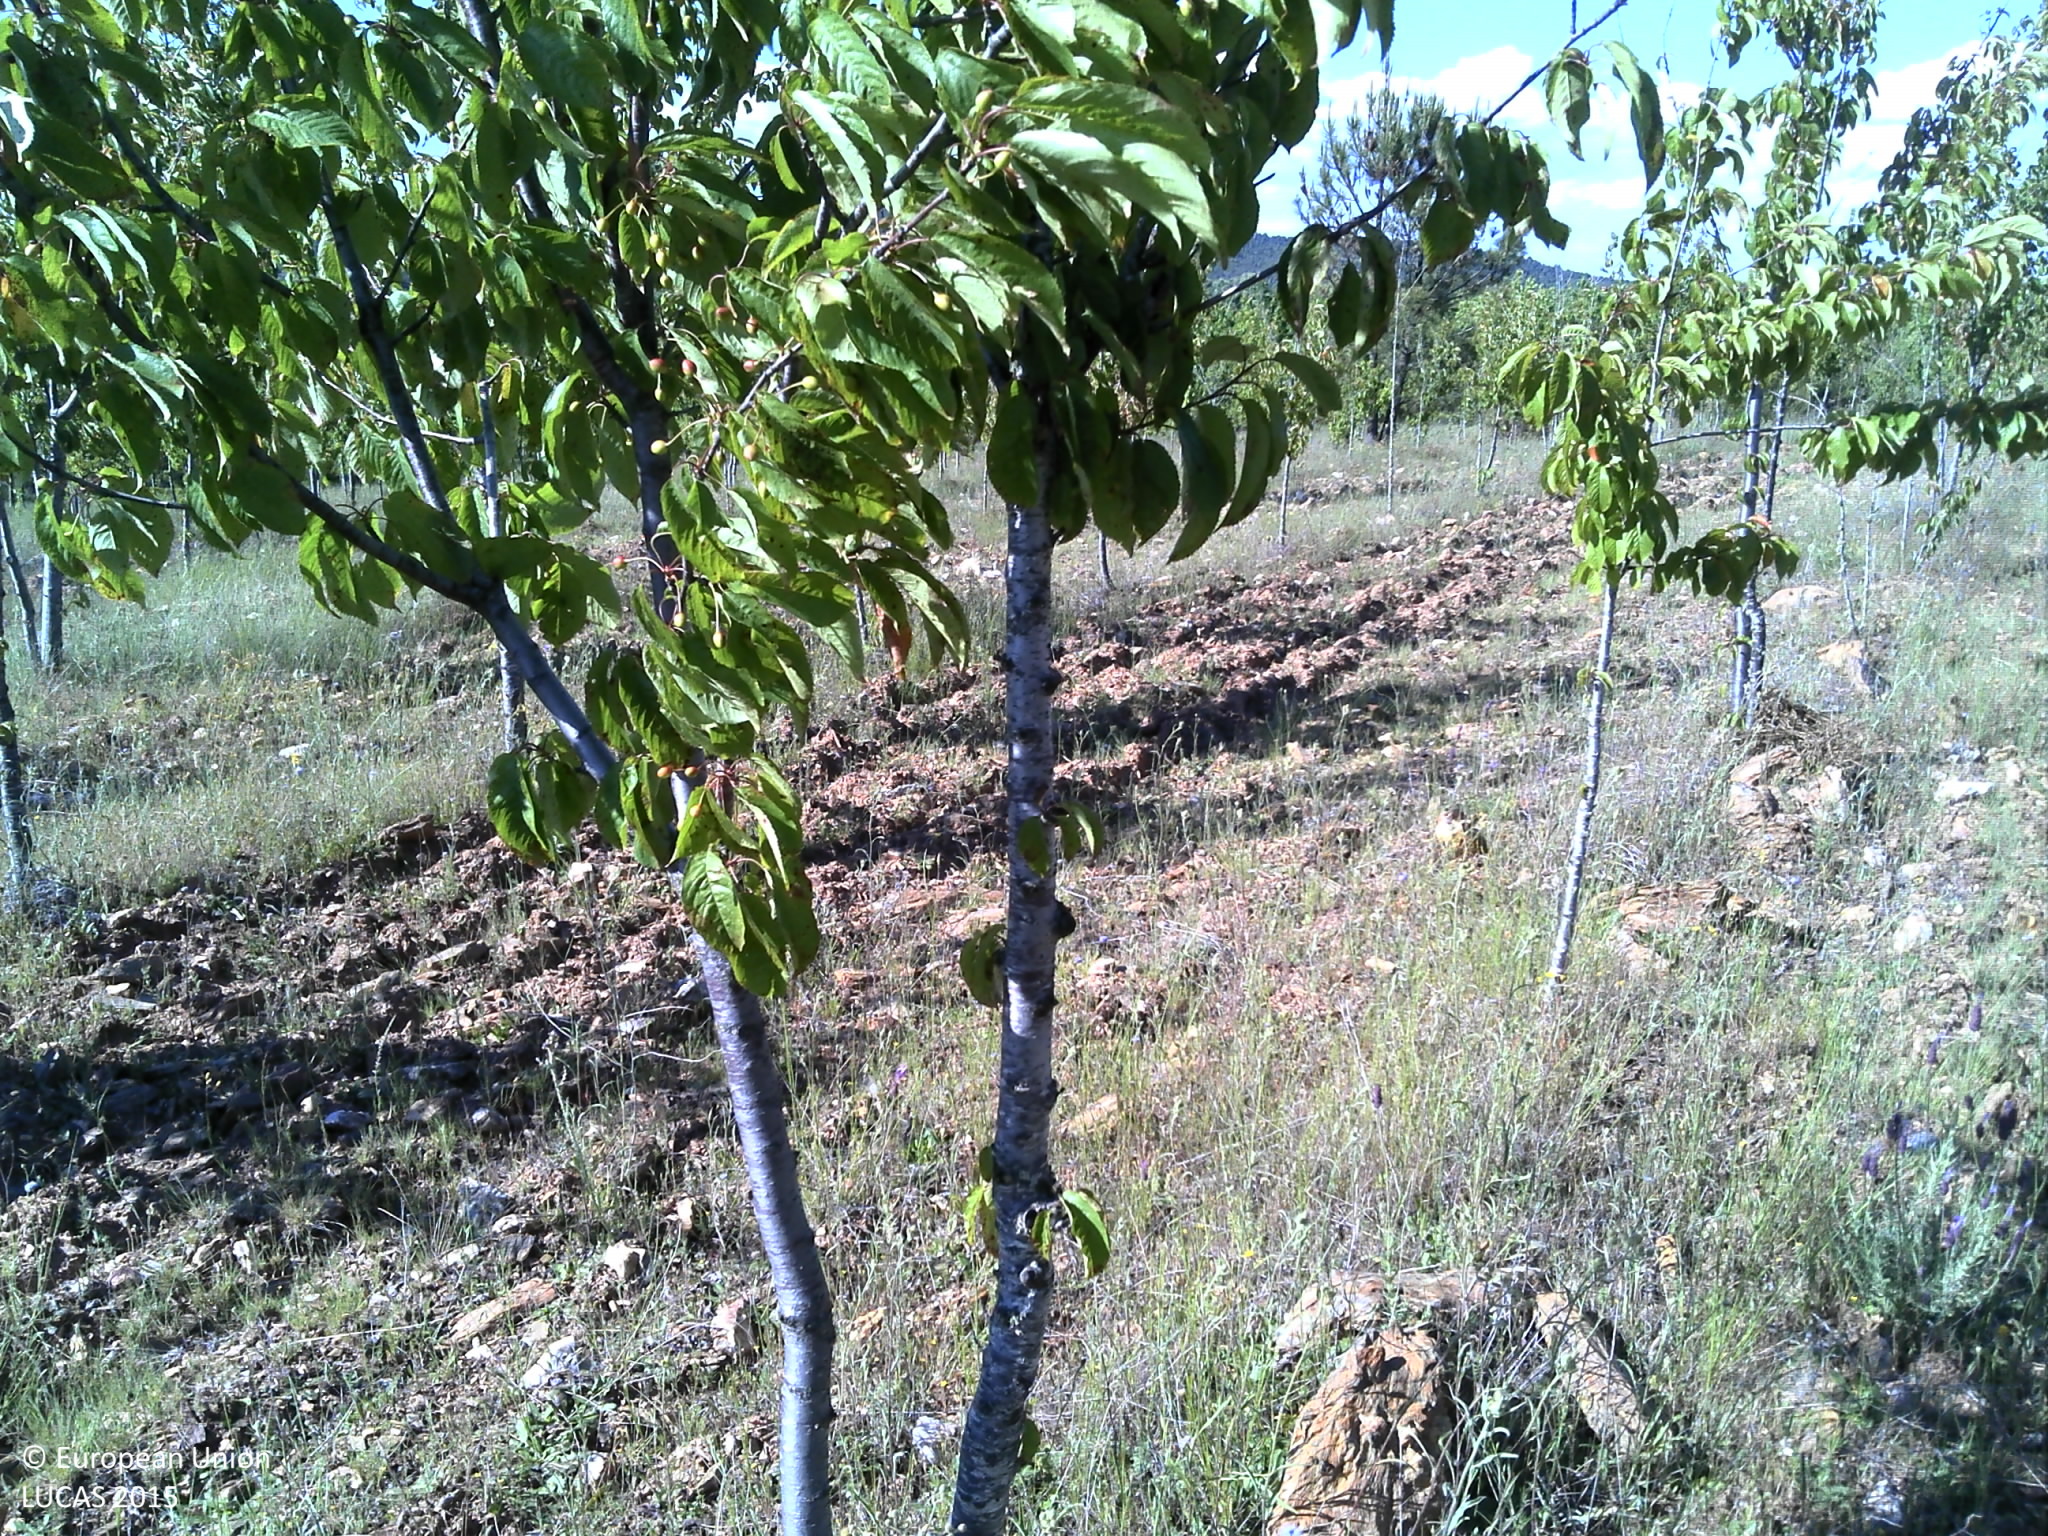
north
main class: Cropland
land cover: Cherry fruit
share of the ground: 25 - 50 %
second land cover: Spontaneously vegetated surfaces
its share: 25 - 50 %
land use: Agriculture (excluding fallow land and kitchen gardens)
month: May
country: PT
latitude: 41.6564
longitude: -6.3981
